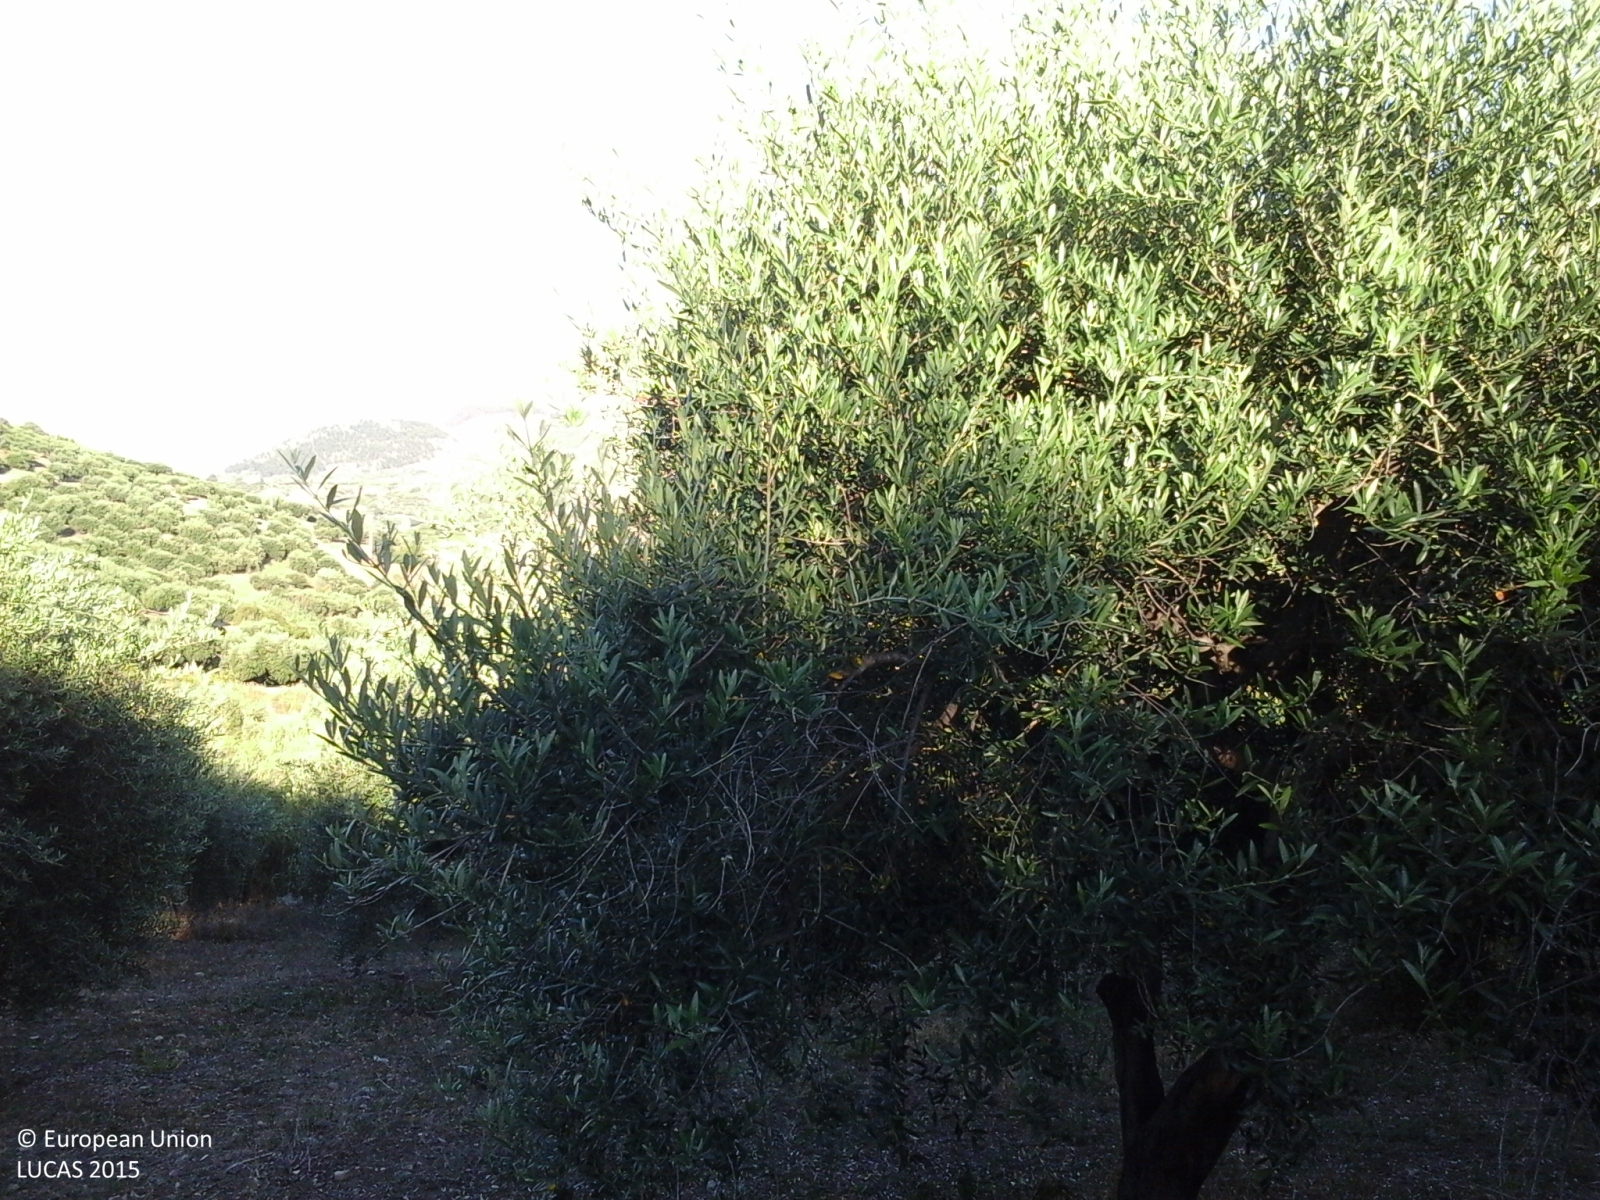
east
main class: Cropland
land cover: Olive groves
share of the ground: 50 - 75 %
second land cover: Spontaneously vegetated surfaces
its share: > 75 %
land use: Agriculture (excluding fallow land and kitchen gardens)
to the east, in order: Olive groves; Spontaneously vegetated surfaces; Grassland without tree/shrub cover; Olive groves
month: June
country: IT
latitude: 38.0276
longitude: 13.5182
